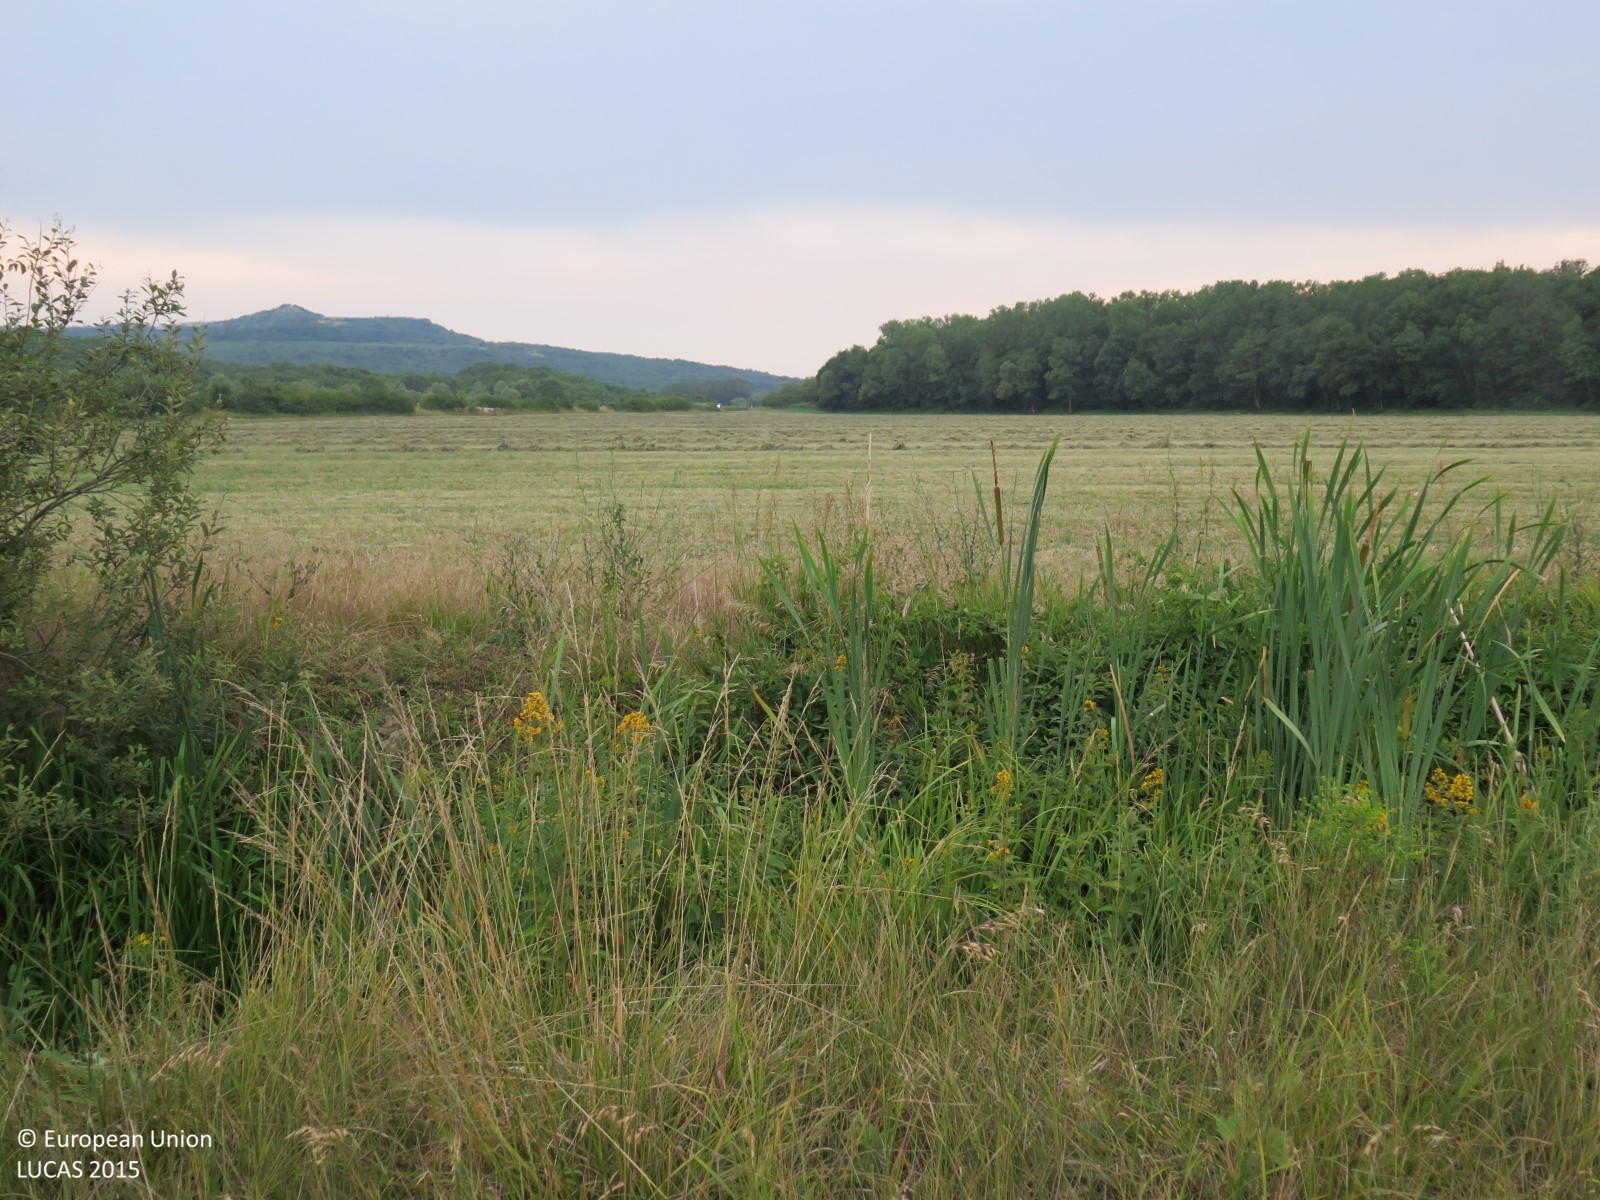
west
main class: Cropland
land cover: Lucerne
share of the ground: > 75 %
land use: Agriculture (excluding fallow land and kitchen gardens)
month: July
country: HR
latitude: 45.3454
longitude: 13.8111
